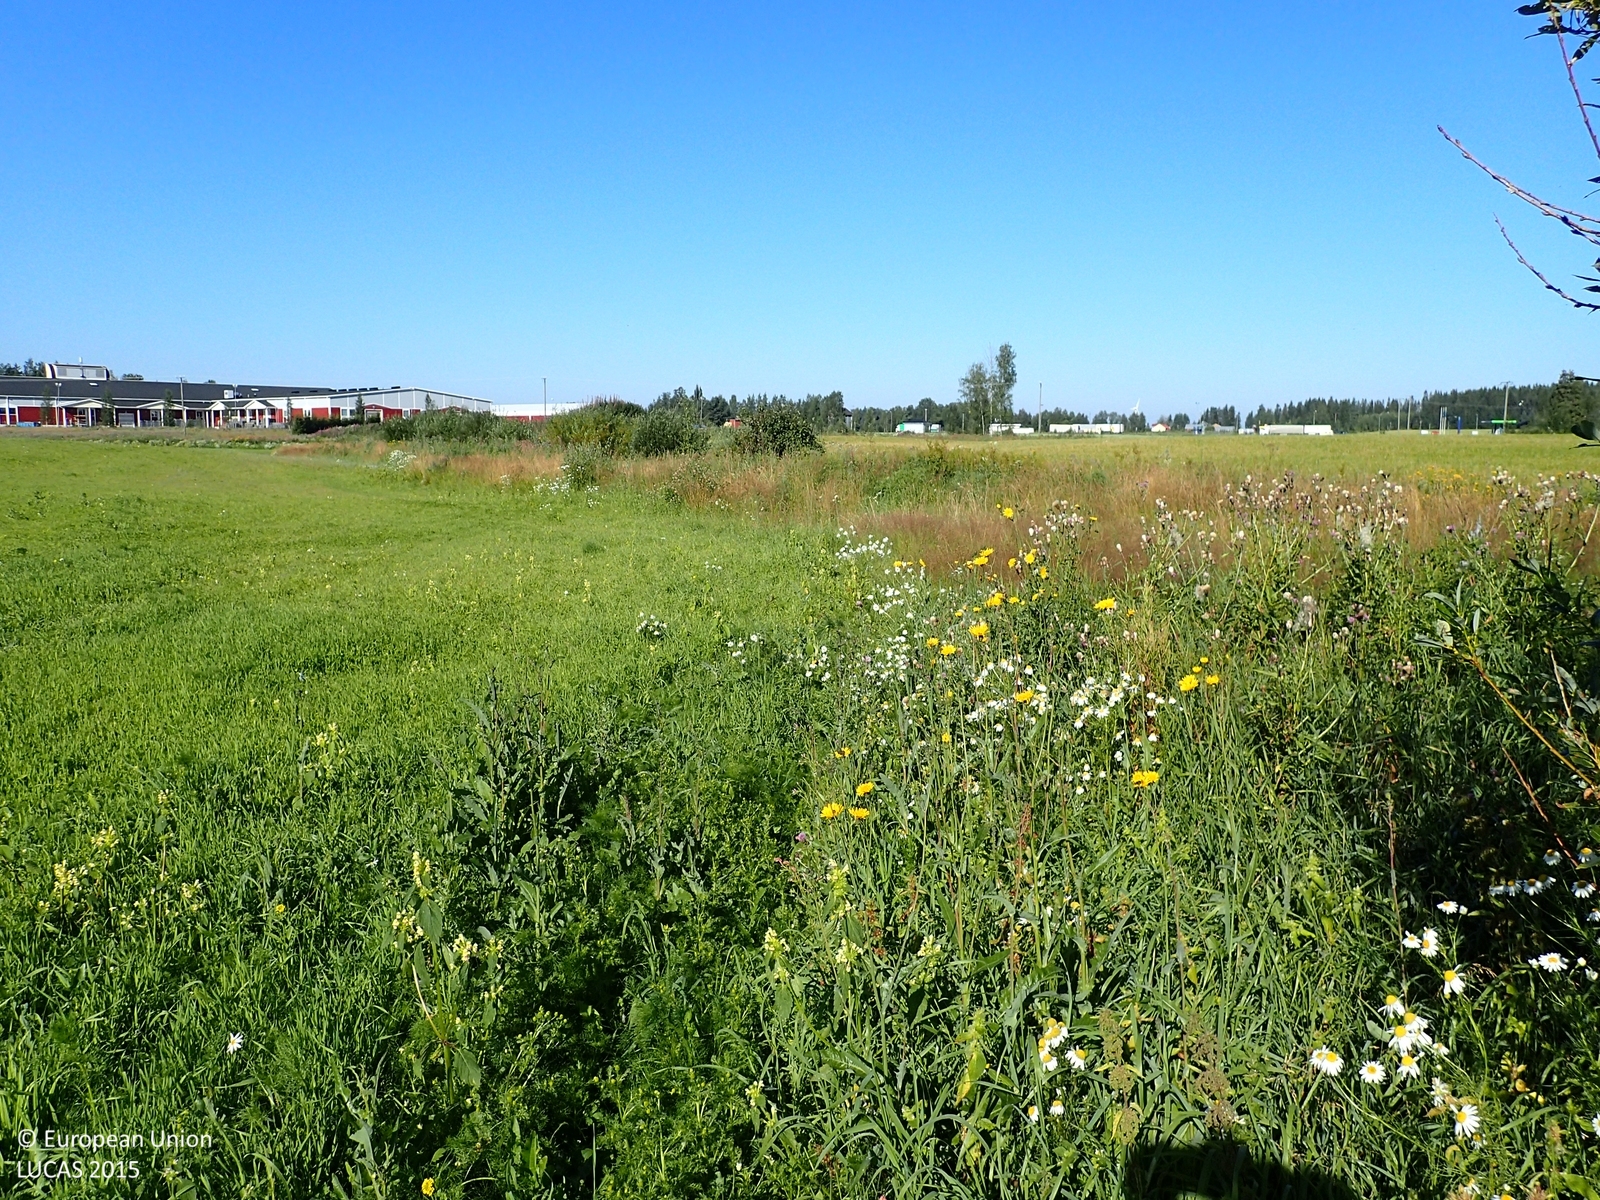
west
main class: Cropland
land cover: Temporary grasslands
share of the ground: > 75 %
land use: Agriculture (excluding fallow land and kitchen gardens)
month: August
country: FI
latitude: 62.5080
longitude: 22.7388
